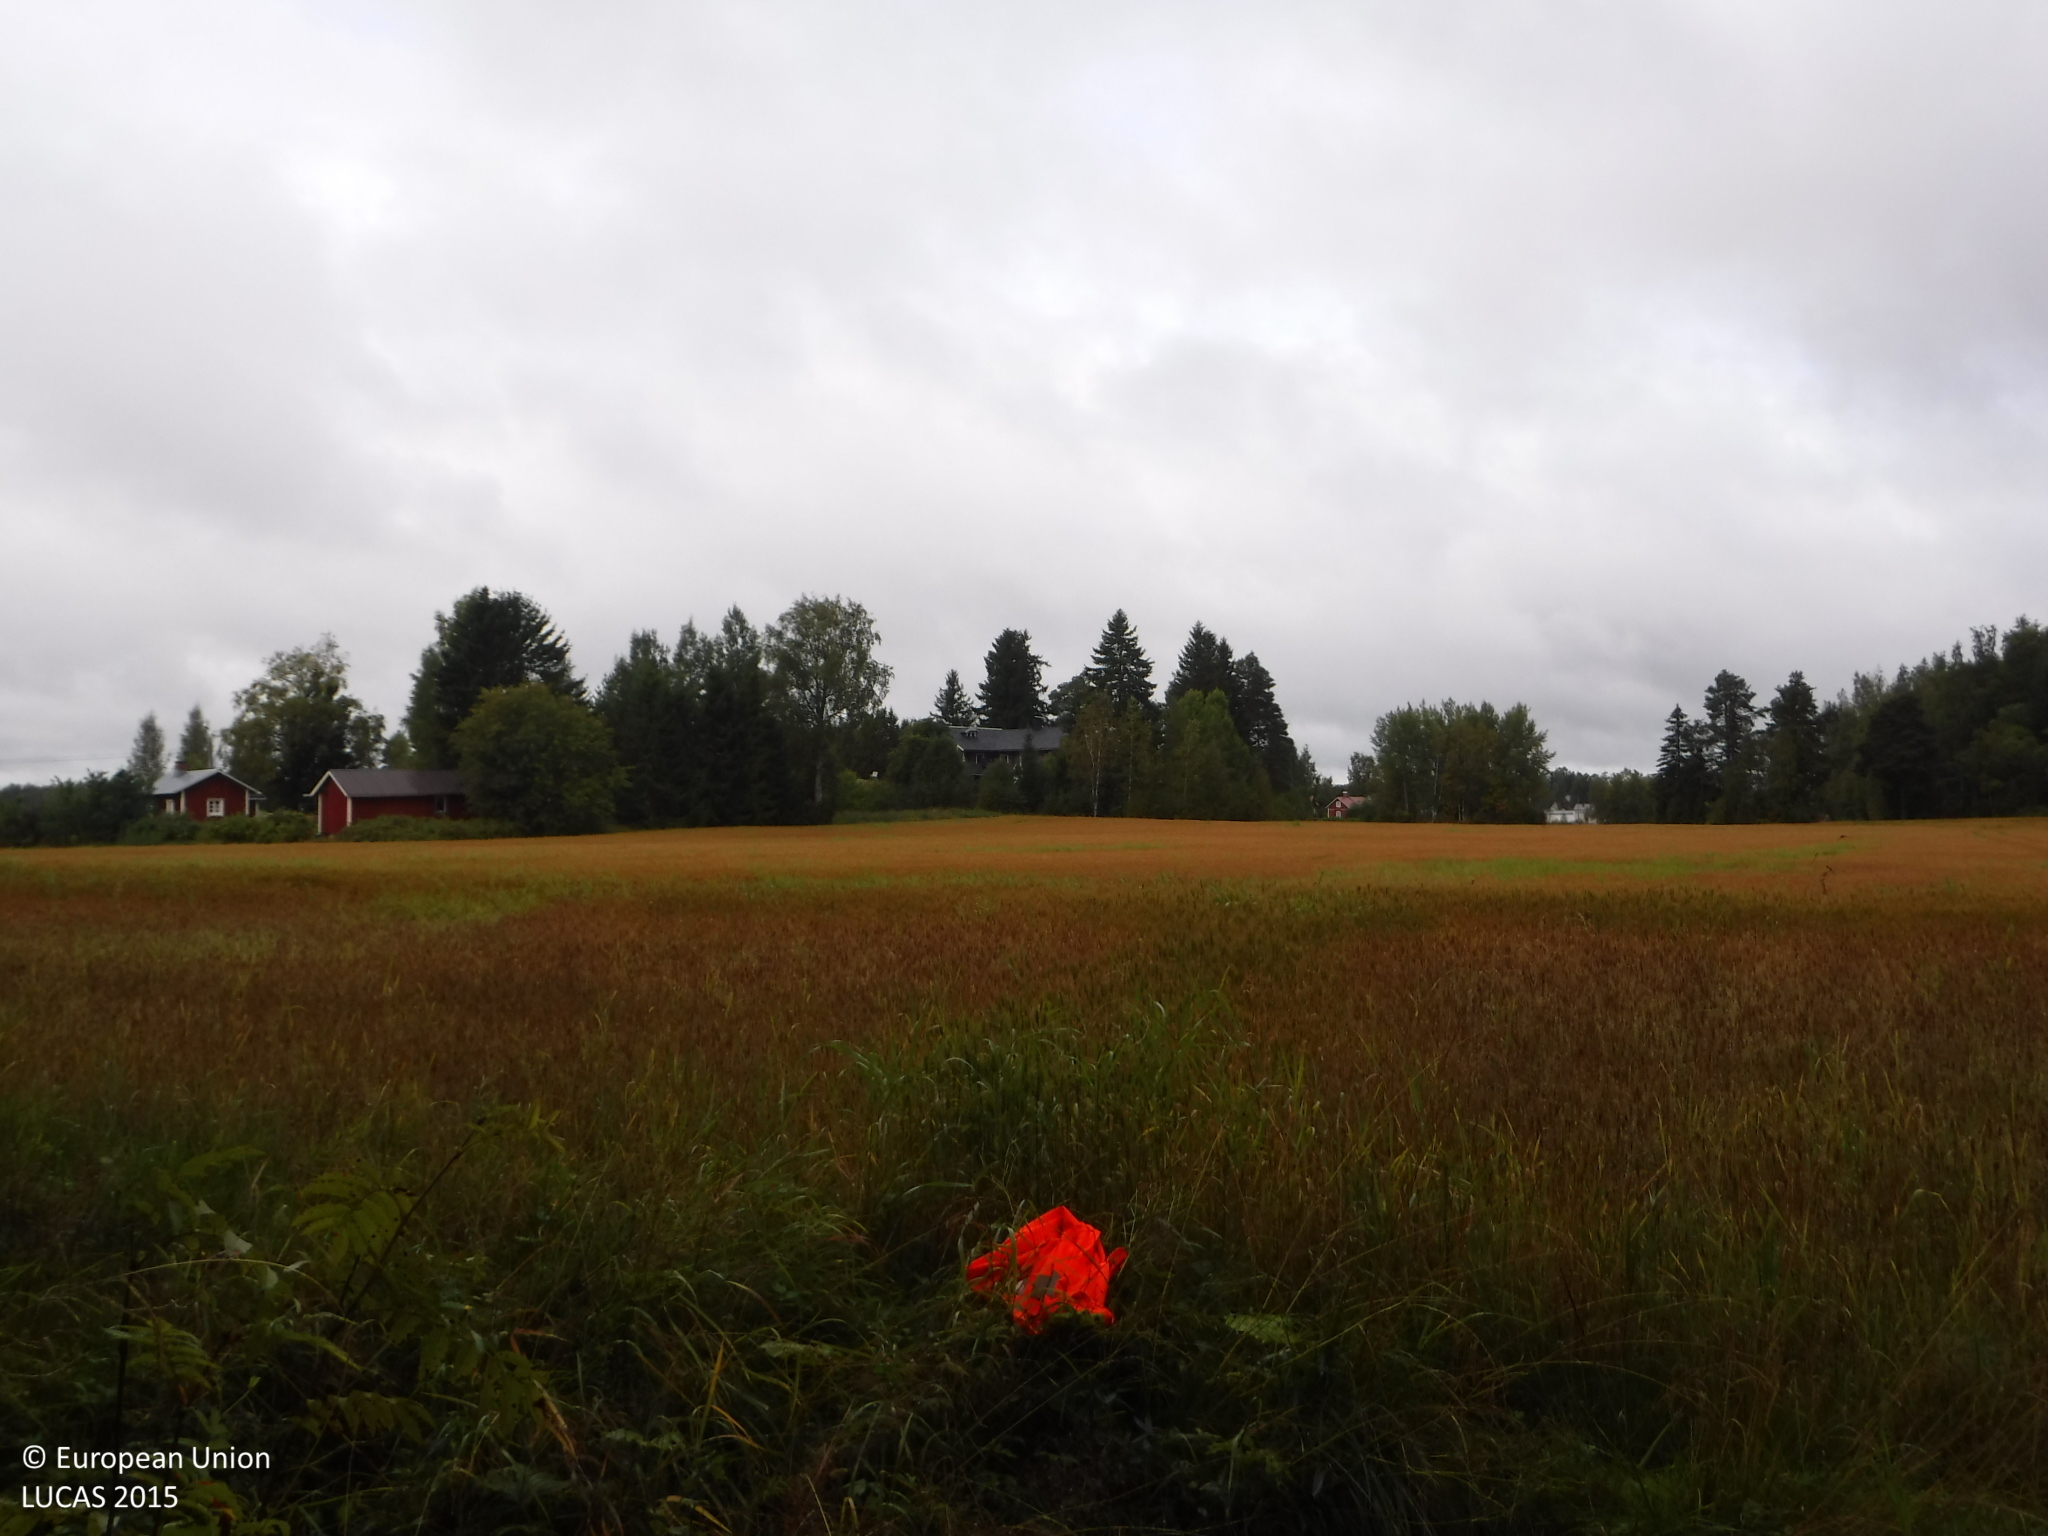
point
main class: Cropland
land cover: Common wheat
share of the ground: > 75 %
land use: Agriculture (excluding fallow land and kitchen gardens)
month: September
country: FI
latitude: 61.3298
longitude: 23.0212
